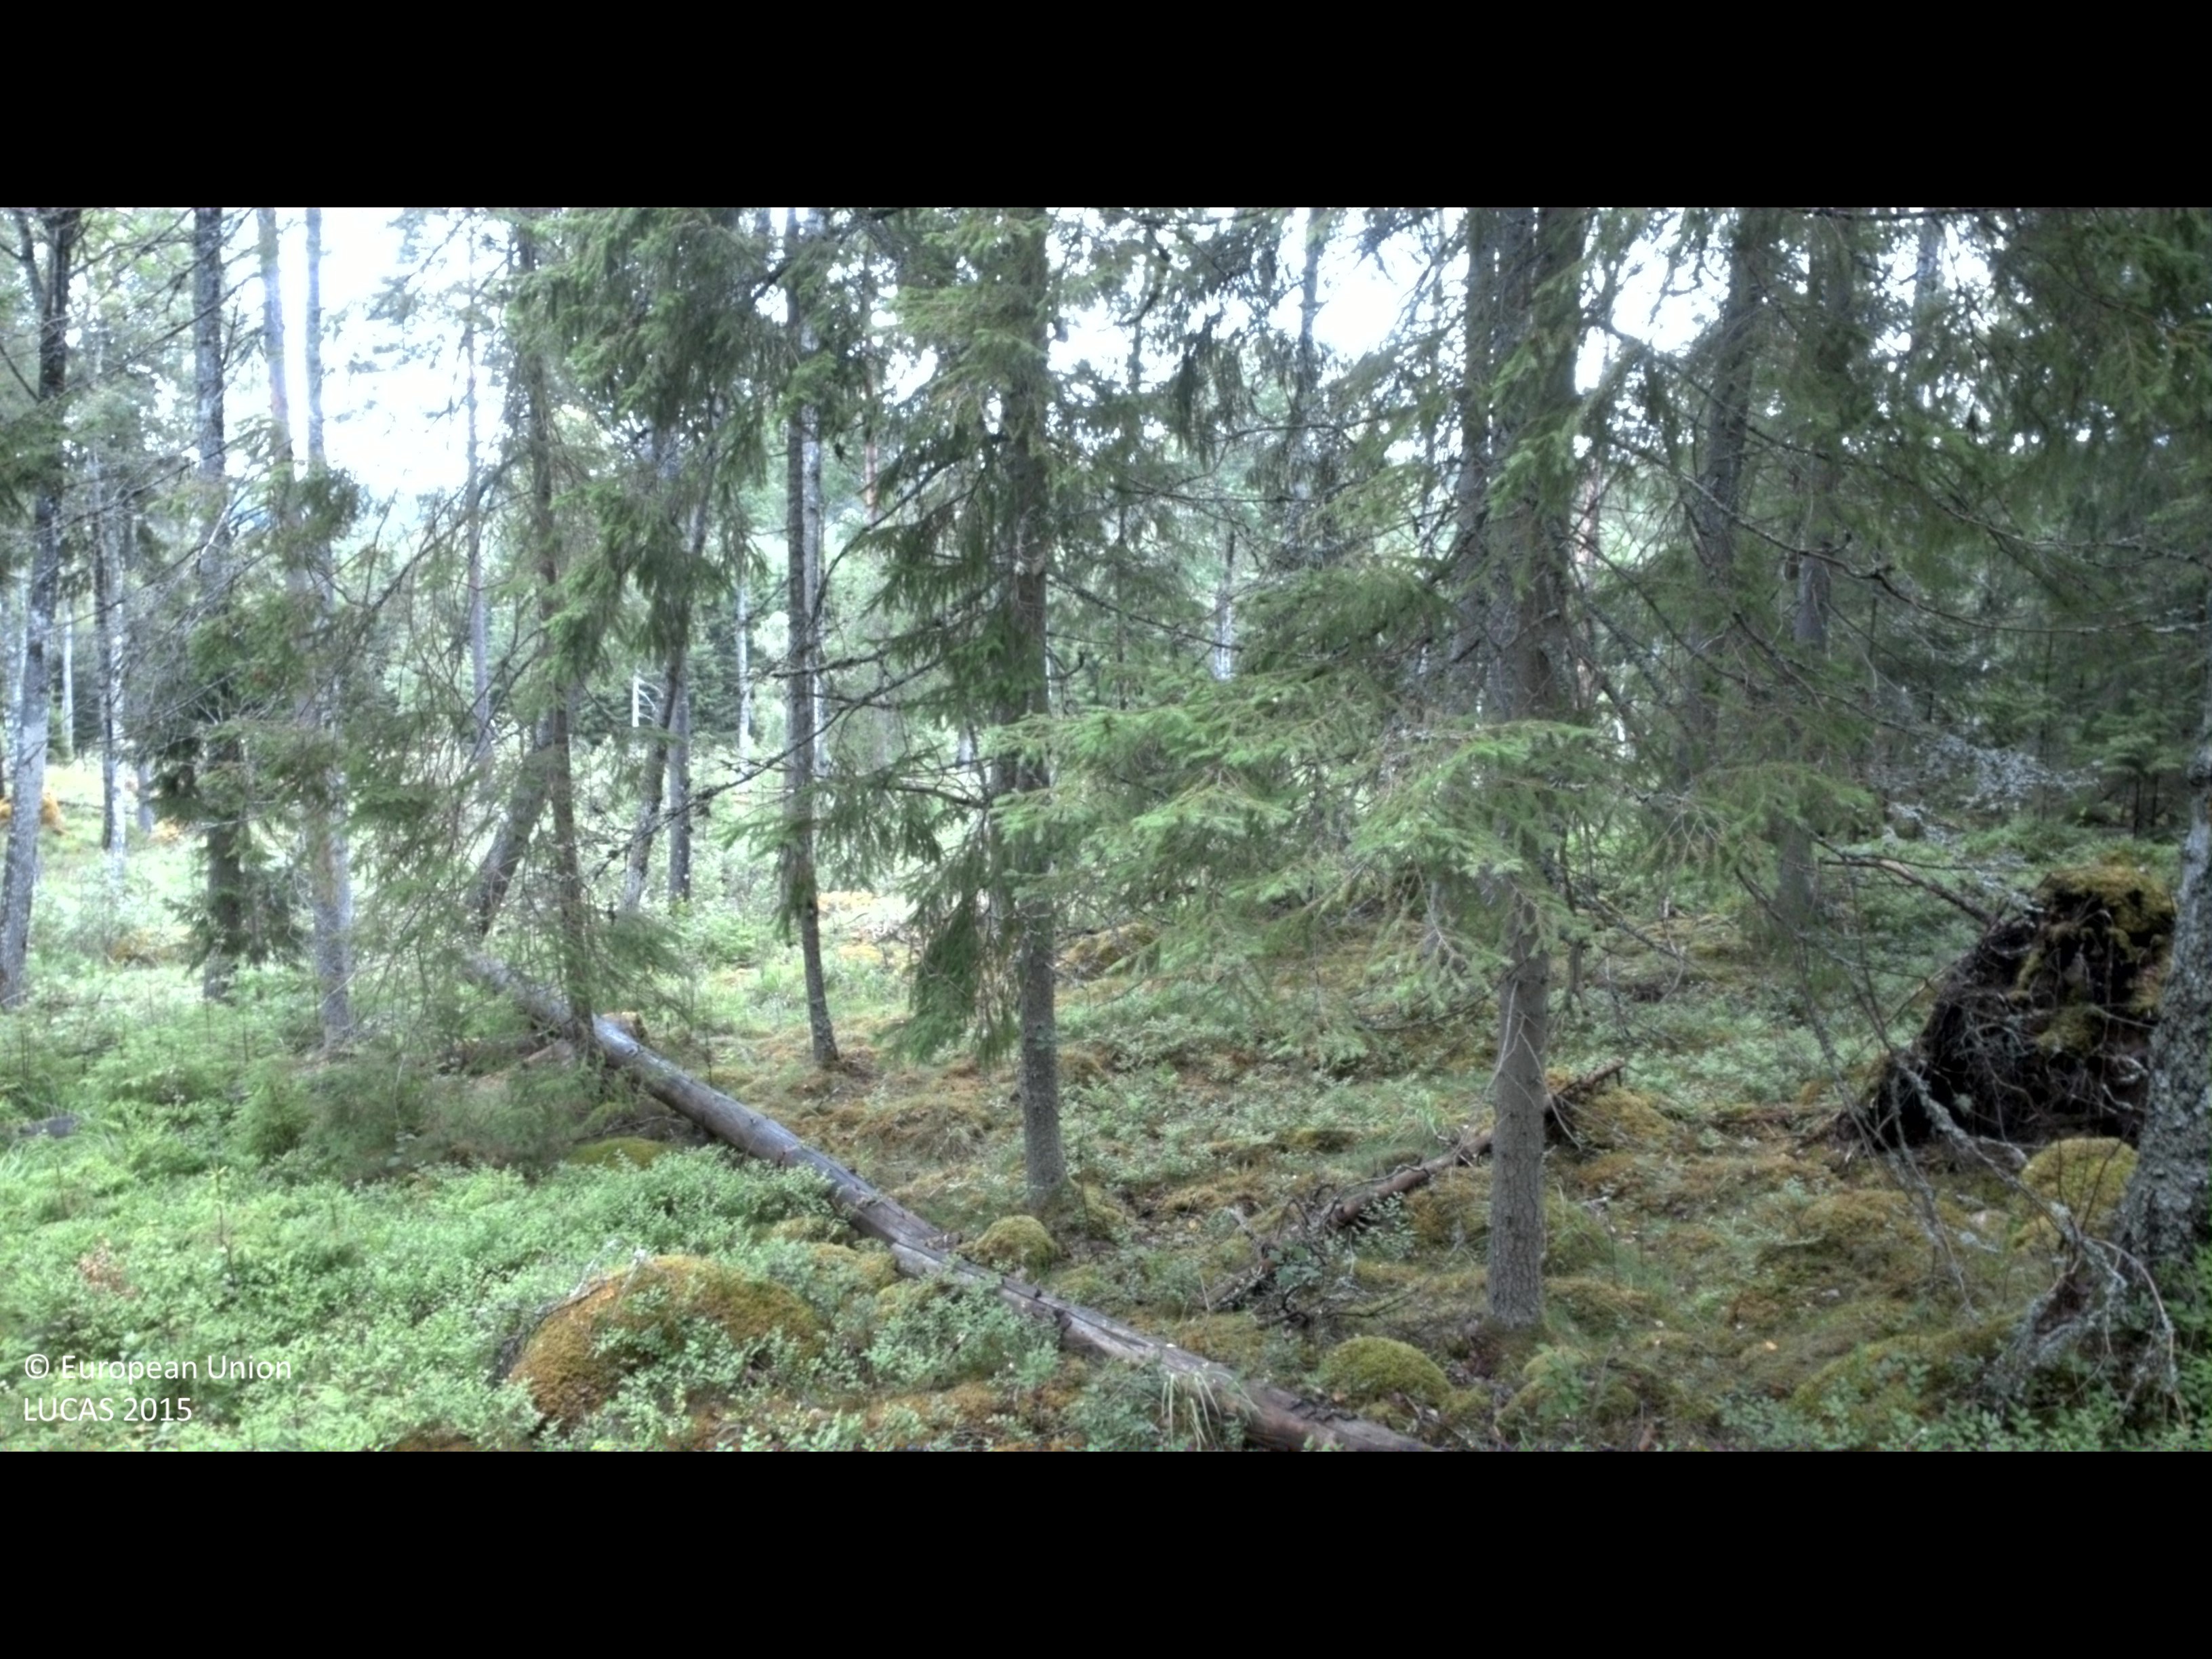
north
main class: Woodland
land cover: Other coniferous woodland
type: boreal forest
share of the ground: 50 - 75 %
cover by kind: coniferous forest trees 55 %, shrubs 35 %, broadleaved forest trees 10 %
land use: Amenities, museums, leisure
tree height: > 5 m
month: July
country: SE
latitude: 58.3115
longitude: 16.1915
